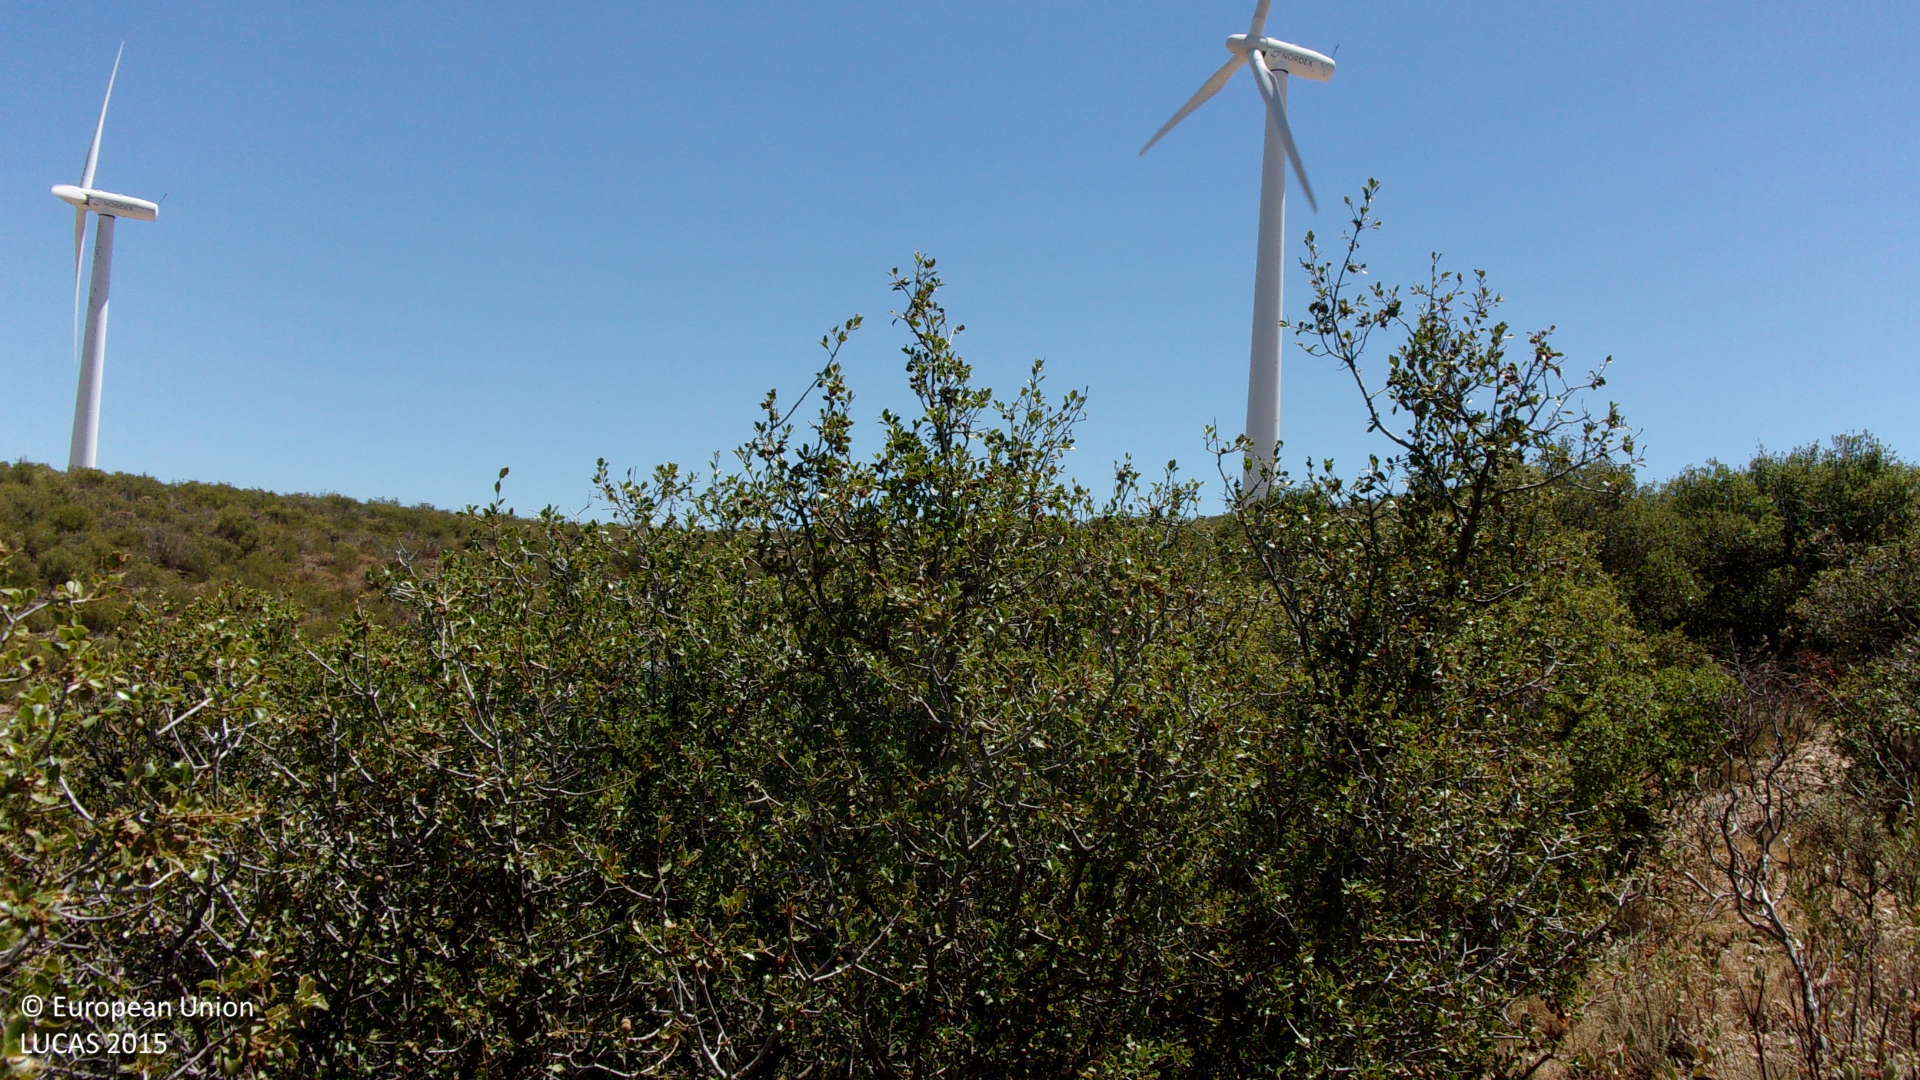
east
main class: Shrubland
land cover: Shrubland without tree cover
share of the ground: > 75 %
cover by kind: shrubs 85 %, consolidated bare surface 10 %, herbaceous plants 5 %
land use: Semi-natural and natural areas not in use
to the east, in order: Shrubland without tree cover; Tracks; Shrubland without tree cover; Other bare soil; Tracks; Other bare soil
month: July
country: ES
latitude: 41.7140
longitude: -1.2633
